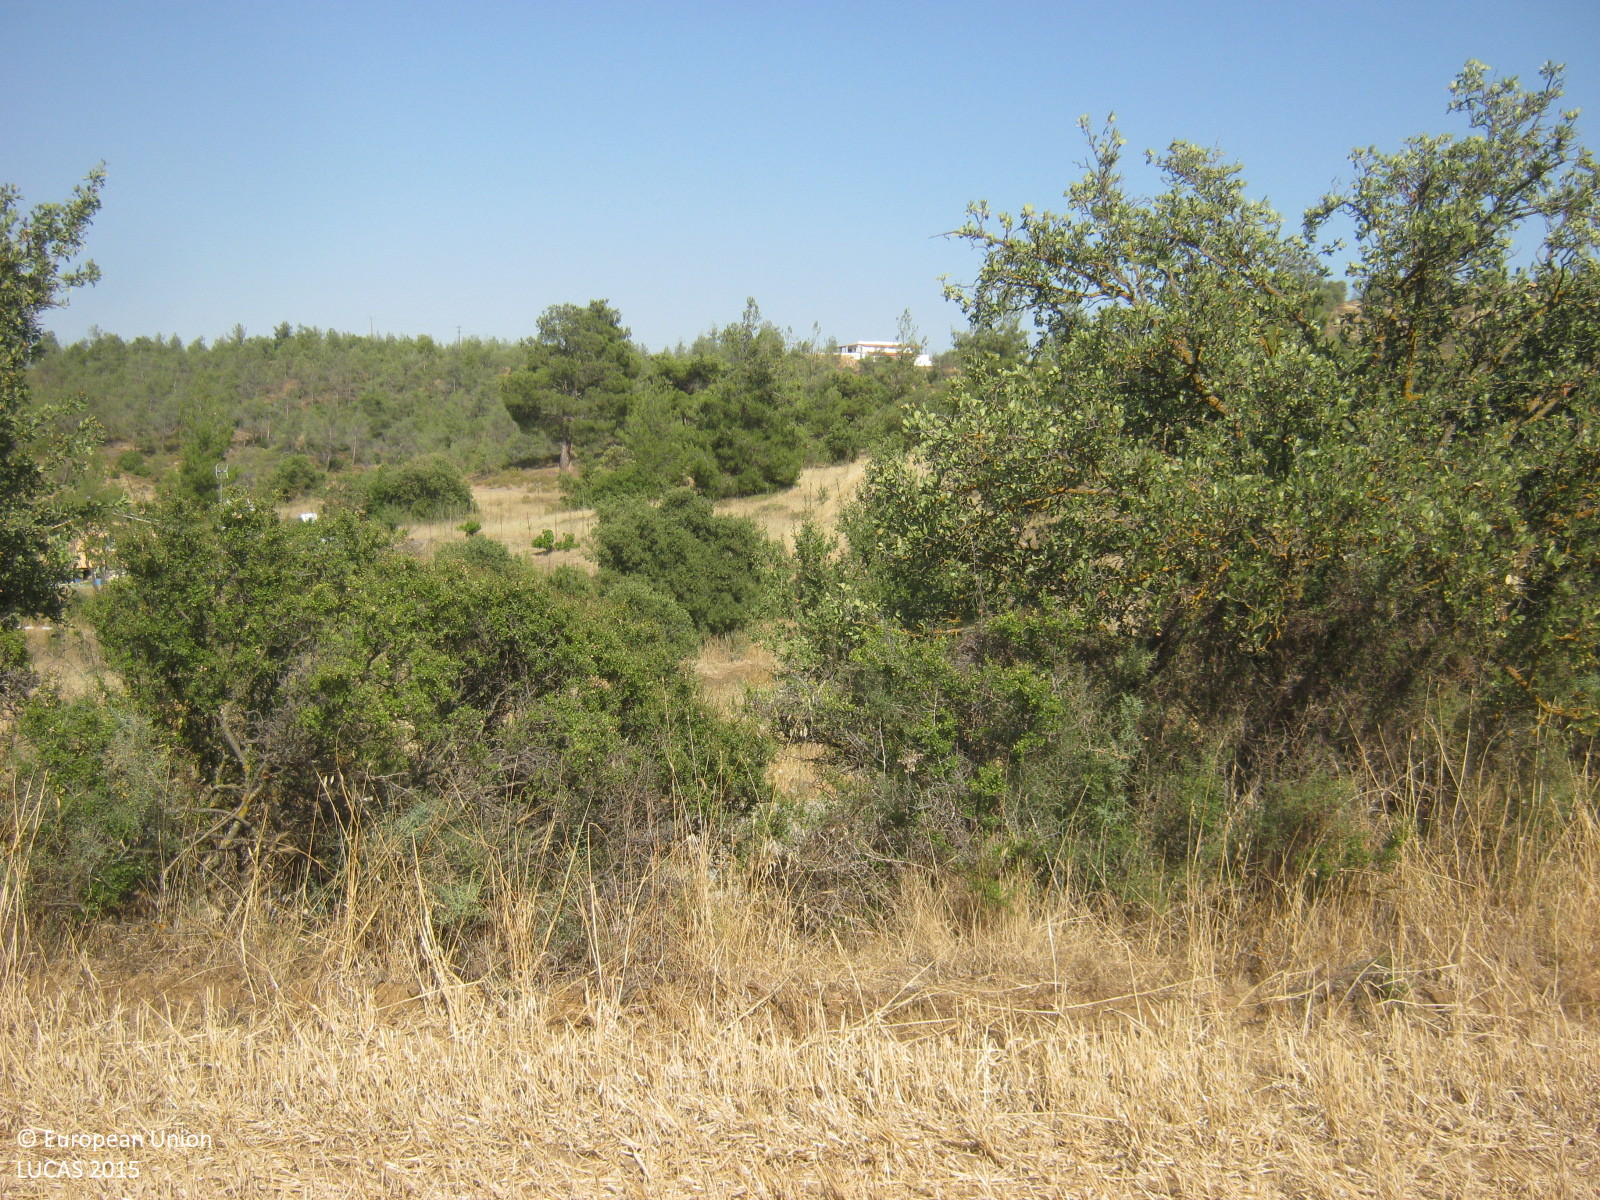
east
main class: Cropland
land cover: Common wheat
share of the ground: < 10 %
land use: Agriculture (excluding fallow land and kitchen gardens)
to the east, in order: Common wheat; Abandoned hedges; Electric lines; Paved roads, cycling and walking lanes; Grassland with sparse tree/shrub cover; Tracks; Grassland with sparse tree/shrub cover; Fences; Lines of trees; Other fruit trees and berries; Artificial constructions in urban areas; Fences; Grassland with sparse tree/shrub cover; Ditches and canals; Shrubland with sparse tree cover; Rivers and streams
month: June
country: CY
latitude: 35.0260
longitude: 33.1192
